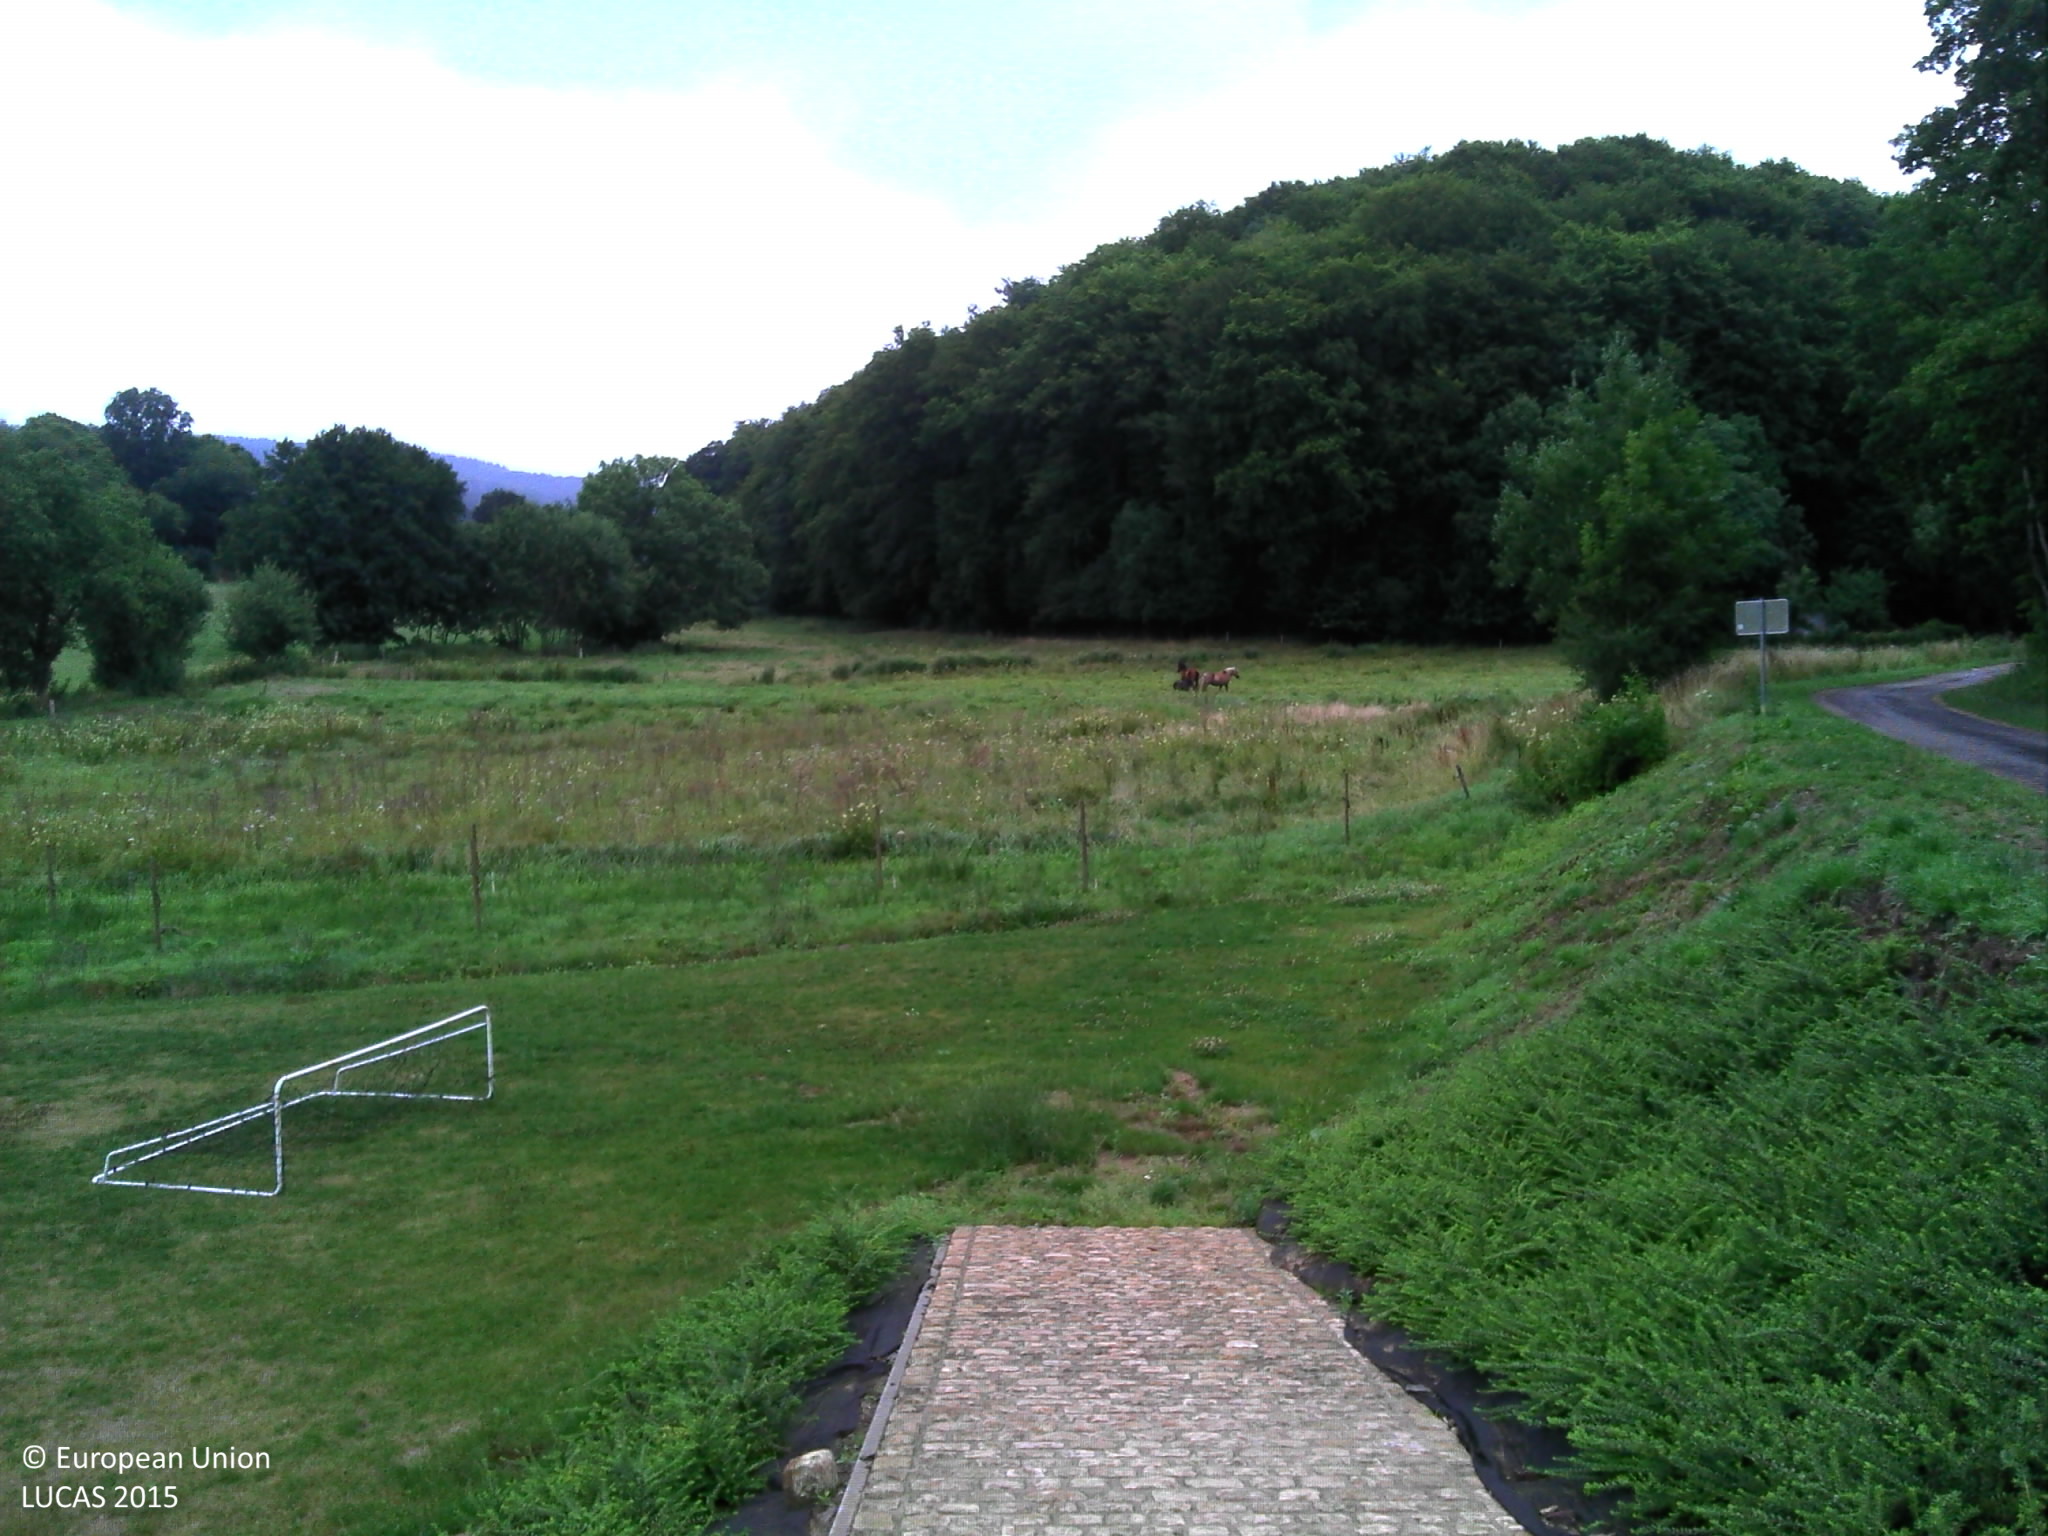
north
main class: Shrubland
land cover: Shrubland without tree cover
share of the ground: > 75 %
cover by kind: shrubs 100 %
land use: Residential
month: July
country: BE
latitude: 49.6388
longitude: 5.8032
